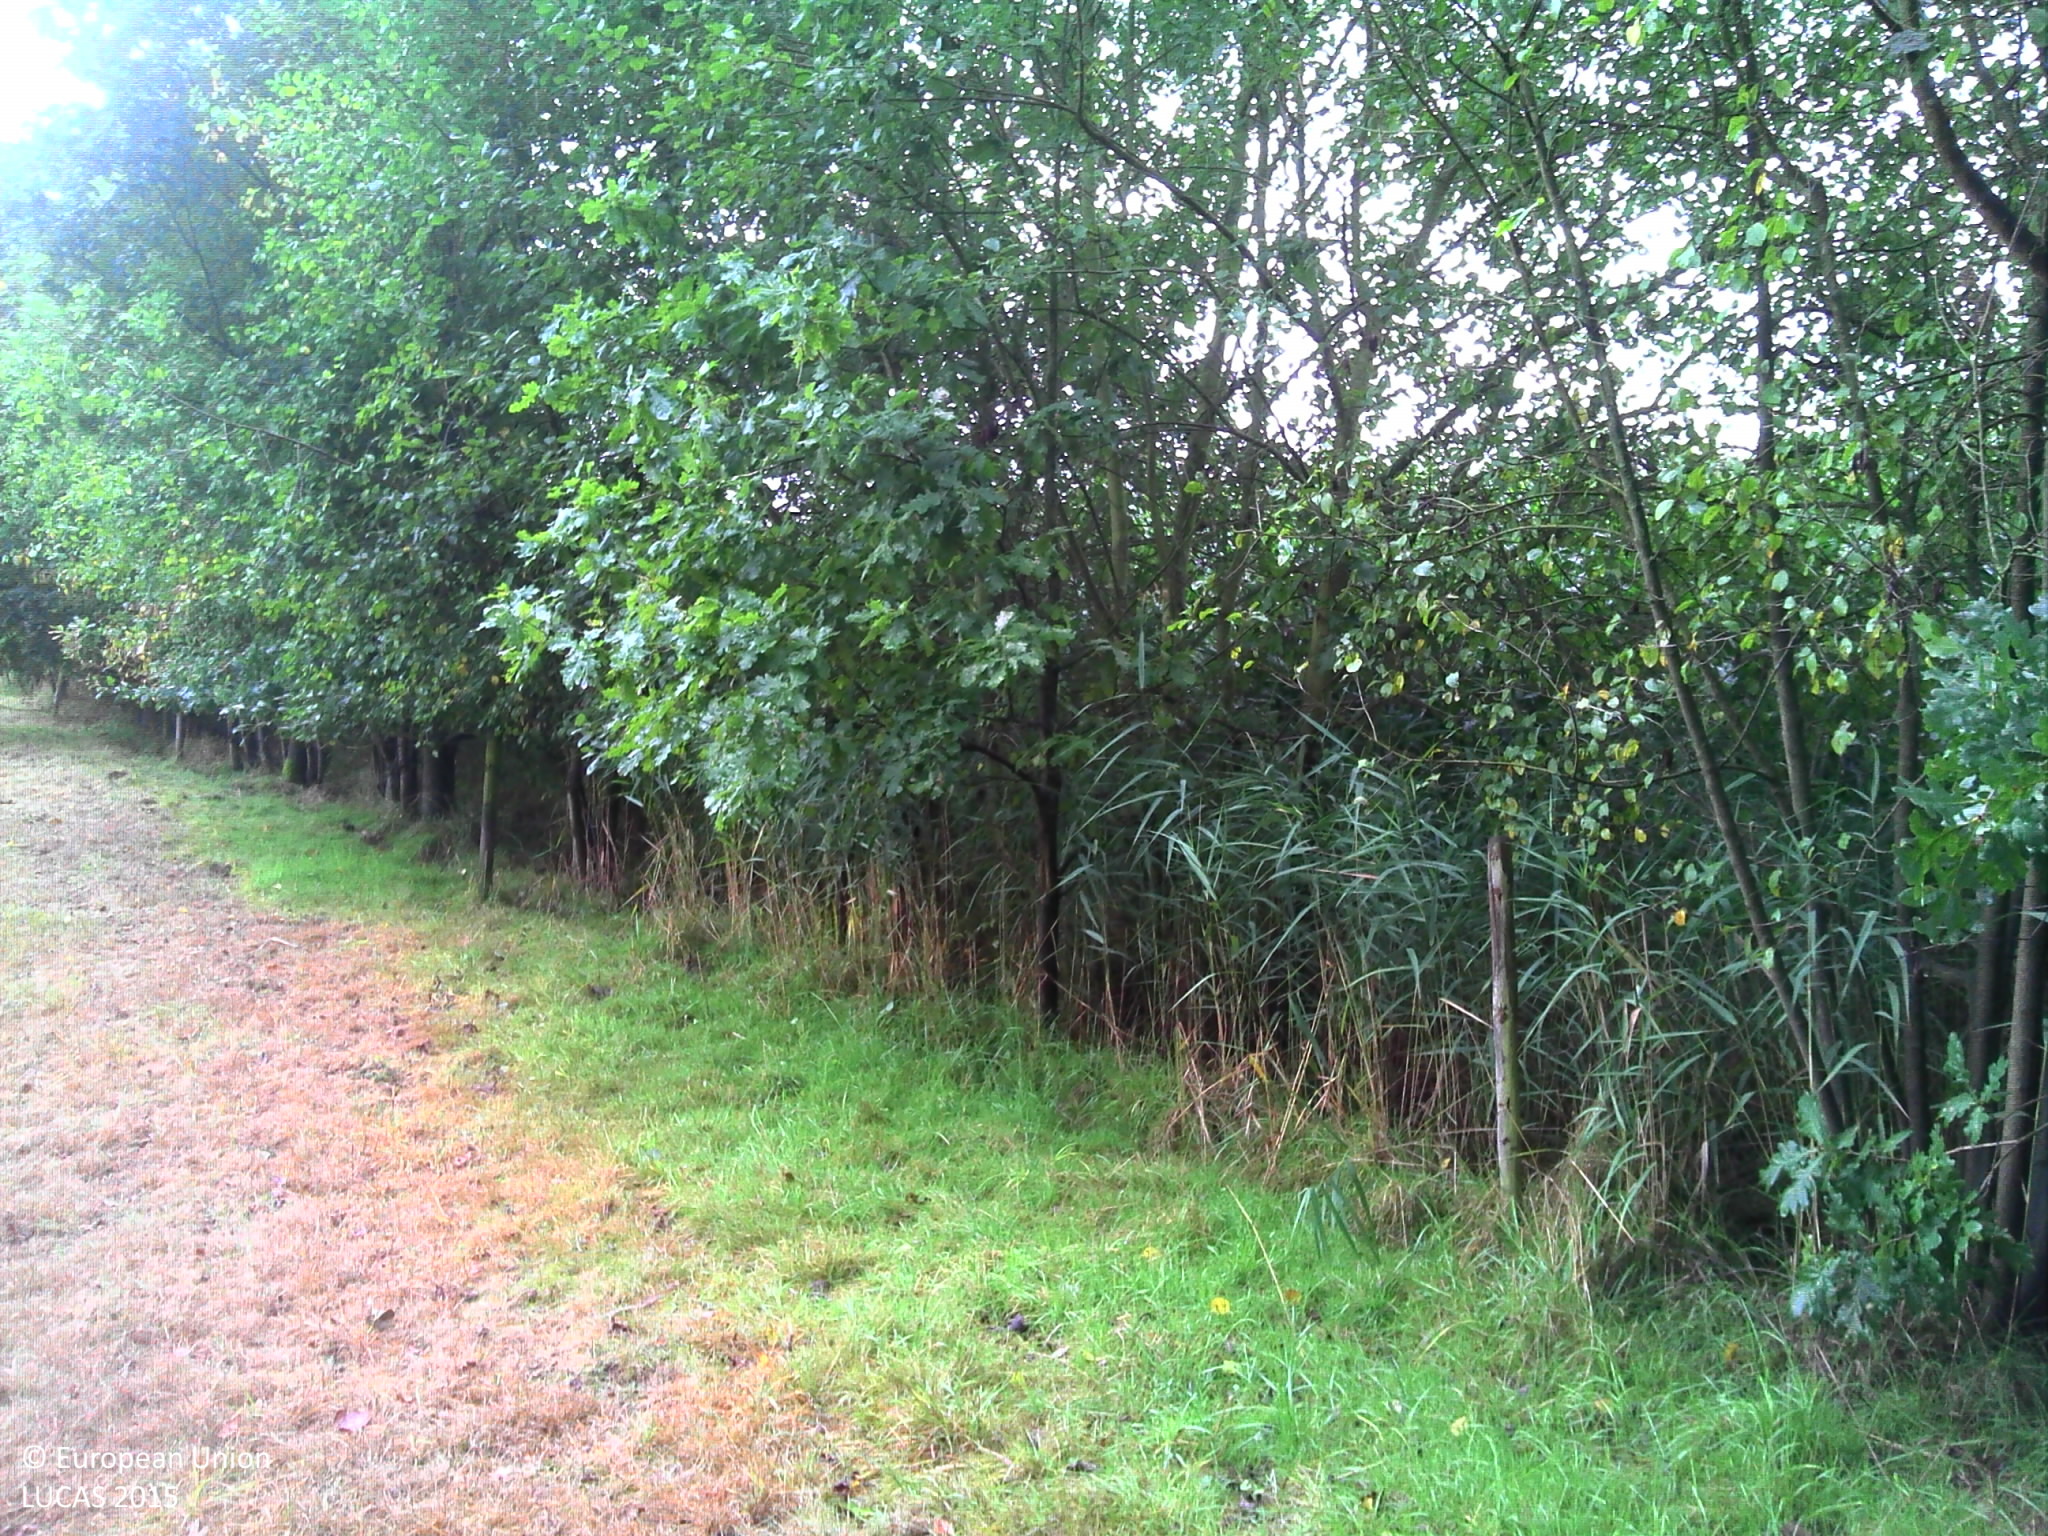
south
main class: Grassland
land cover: Grassland without tree/shrub cover
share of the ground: > 75 %
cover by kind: herbaceous plants 100 %
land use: Agriculture (excluding fallow land and kitchen gardens)
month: September
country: BE
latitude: 51.2481
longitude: 4.6524
